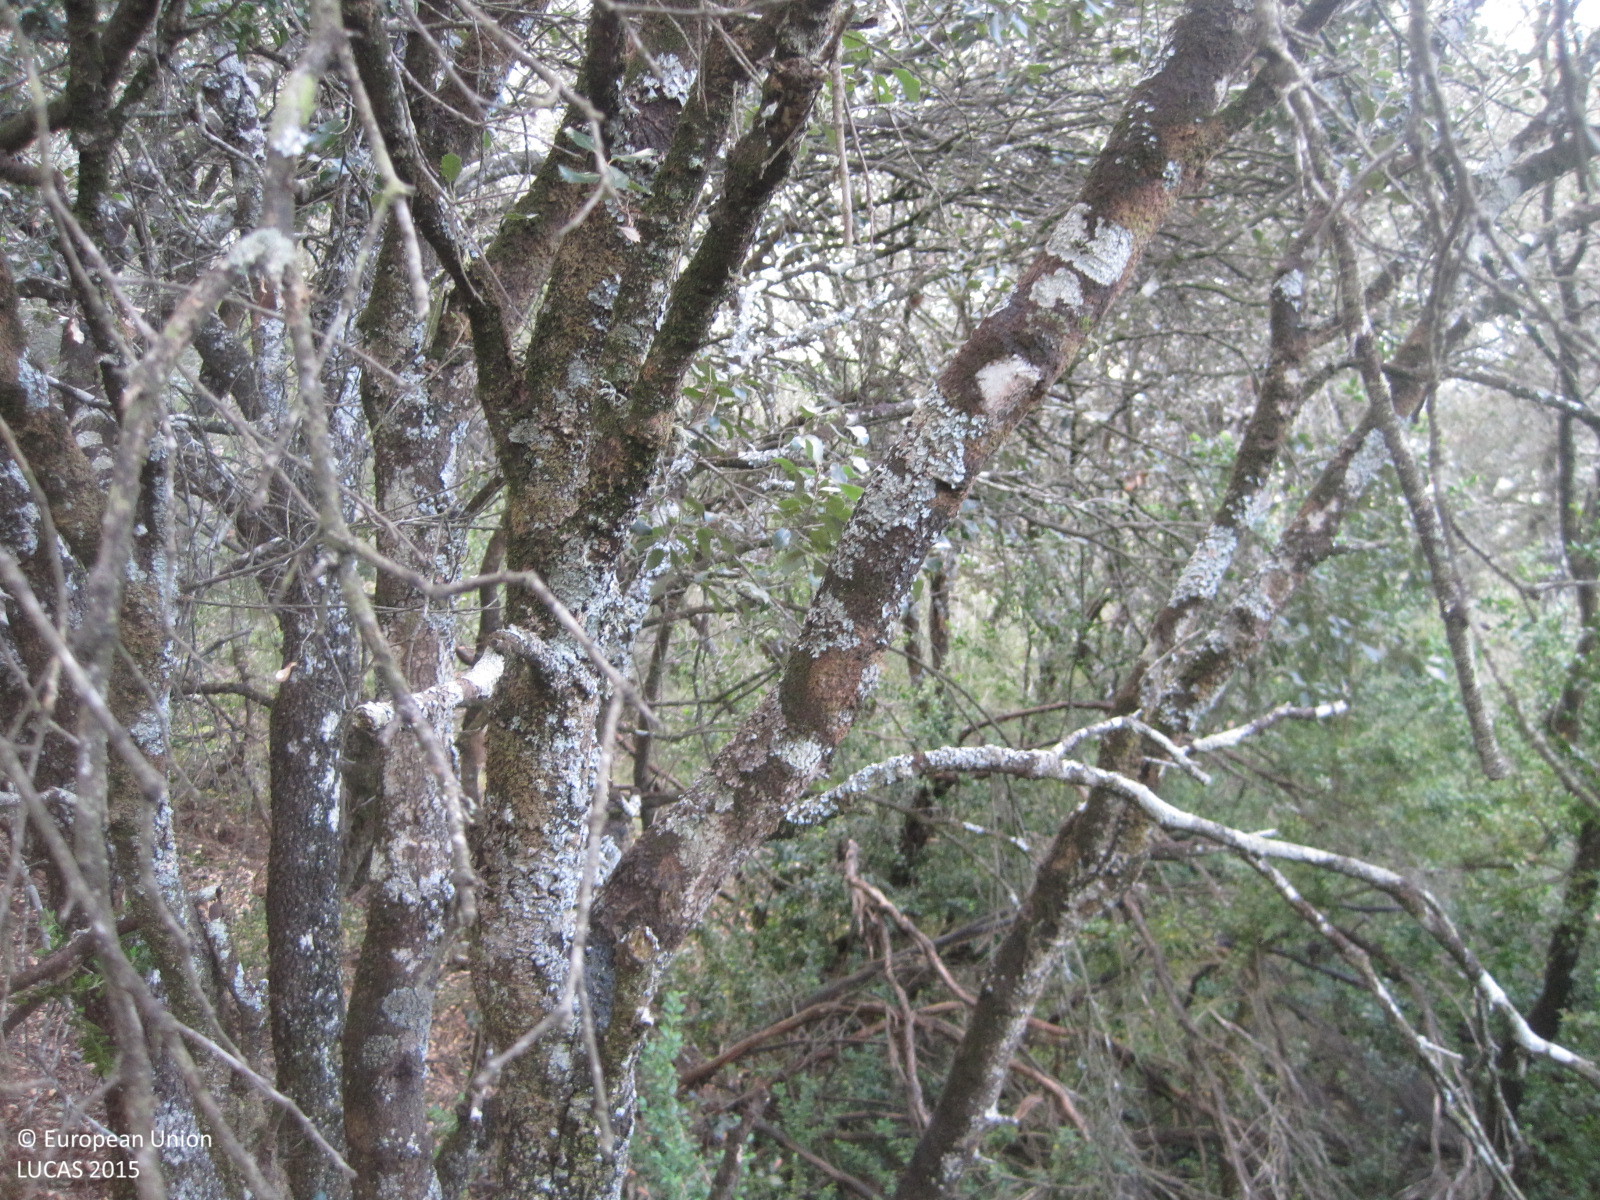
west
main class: Woodland
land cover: Broadleaved woodland
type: acidophilous oak and oak-birch forest
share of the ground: > 75 %
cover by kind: broadleaved forest trees 100 %
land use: Forestry
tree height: > 5 m
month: April
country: ES
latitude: 42.6577
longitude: -2.2311
